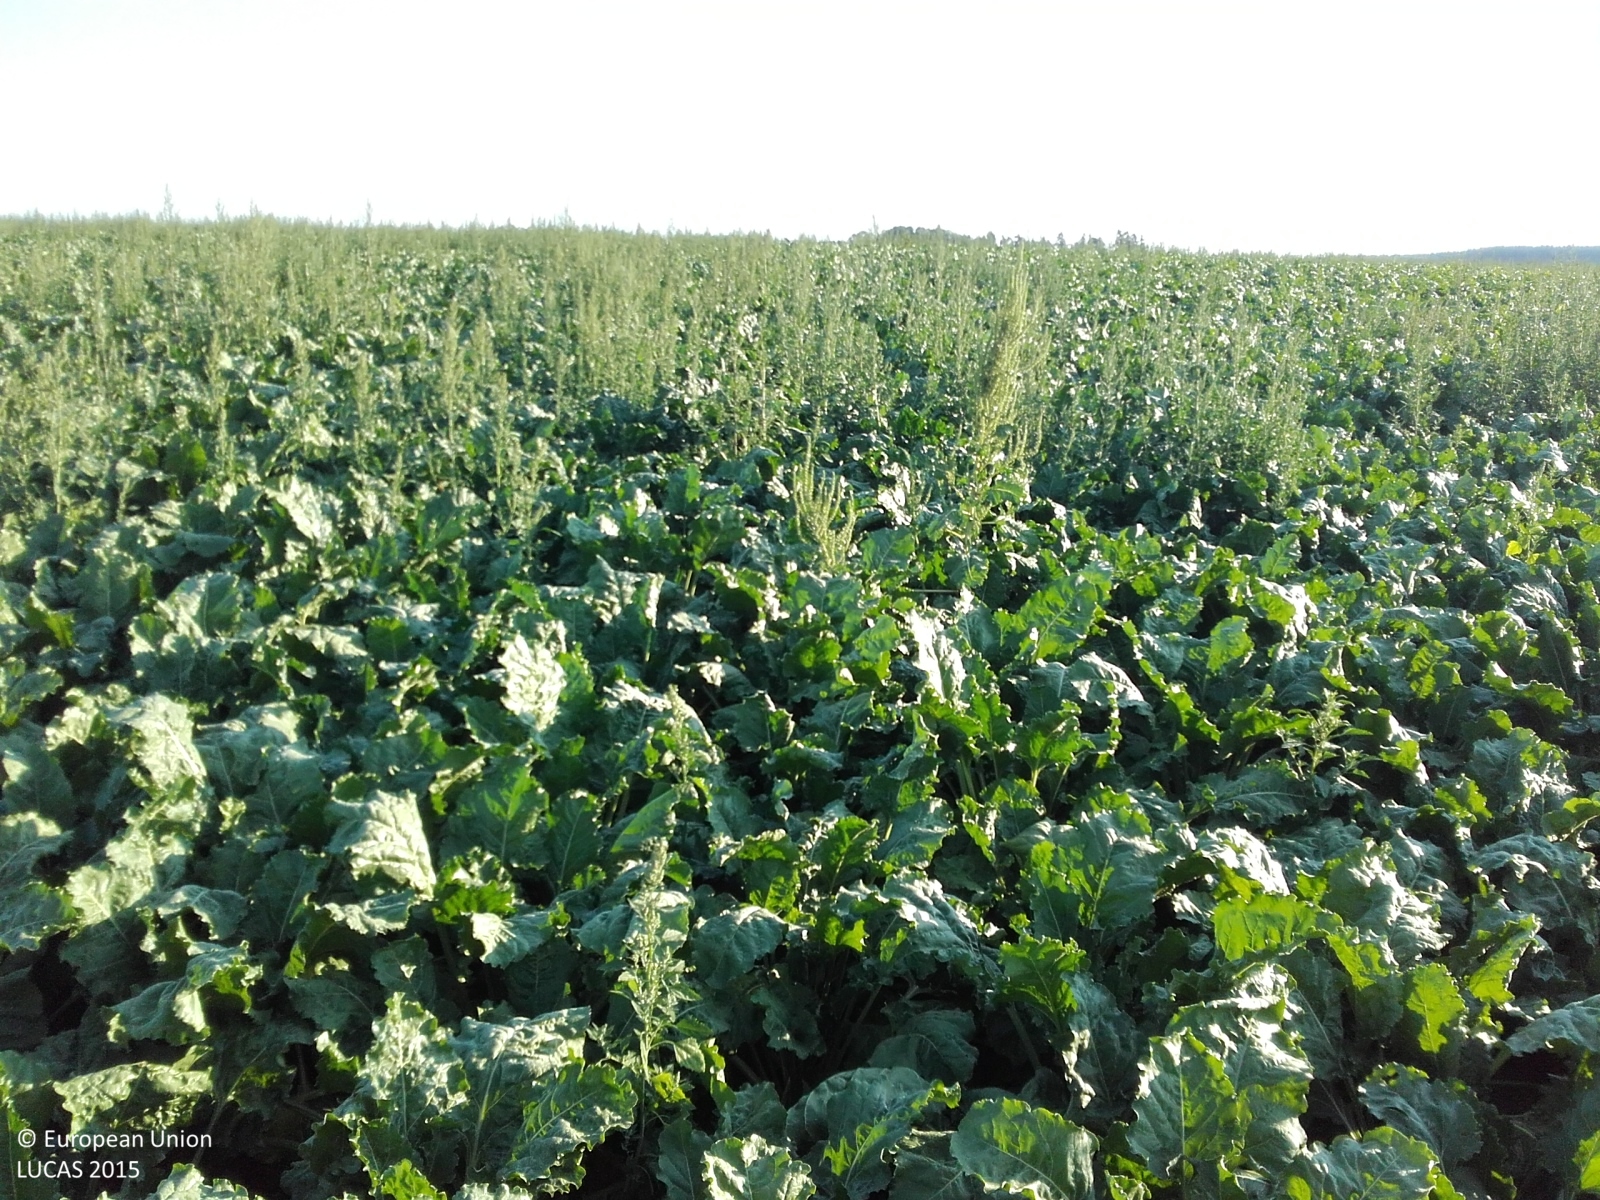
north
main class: Cropland
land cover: Sugar beet
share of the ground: > 75 %
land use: Agriculture (excluding fallow land and kitchen gardens)
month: July
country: CZ
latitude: 49.8995
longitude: 16.3413
